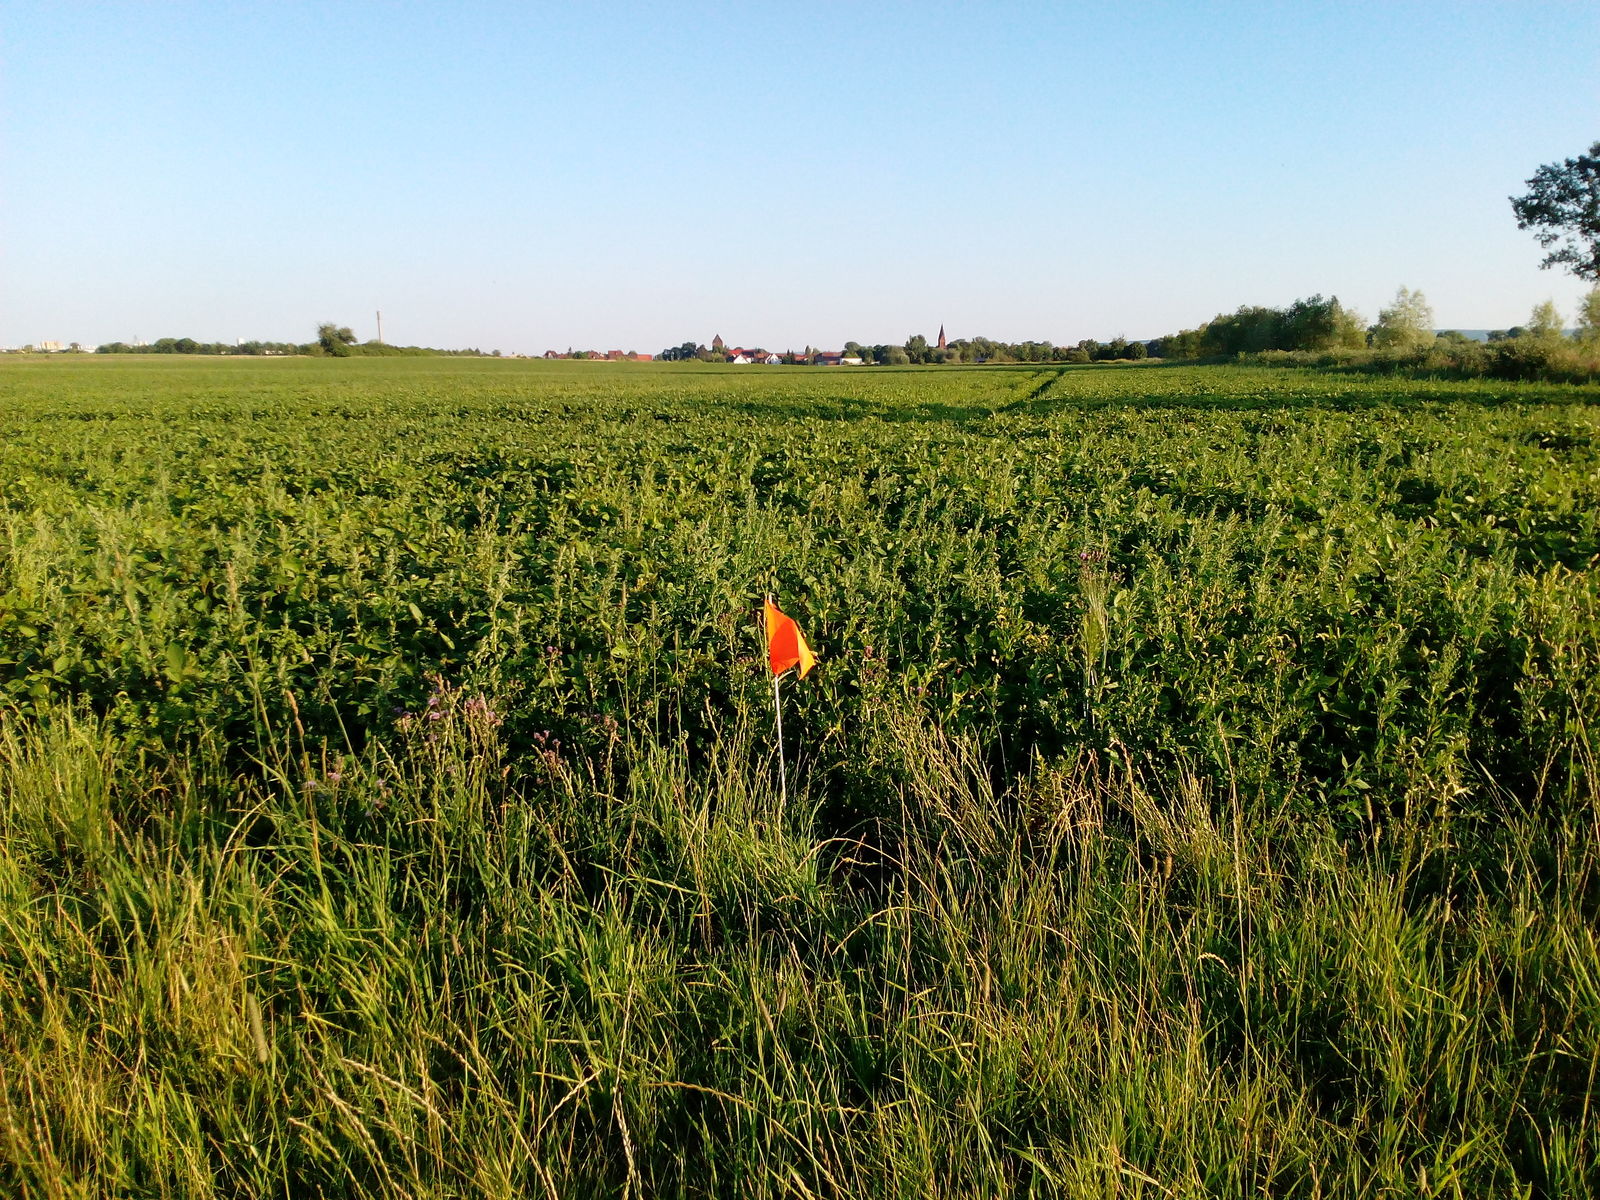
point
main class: Grassland
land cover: Grassland without tree/shrub cover
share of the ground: > 75 %
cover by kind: herbaceous plants 100 %
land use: Agriculture (excluding fallow land and kitchen gardens)
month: July
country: DE
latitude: 51.1152
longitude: 10.9568
